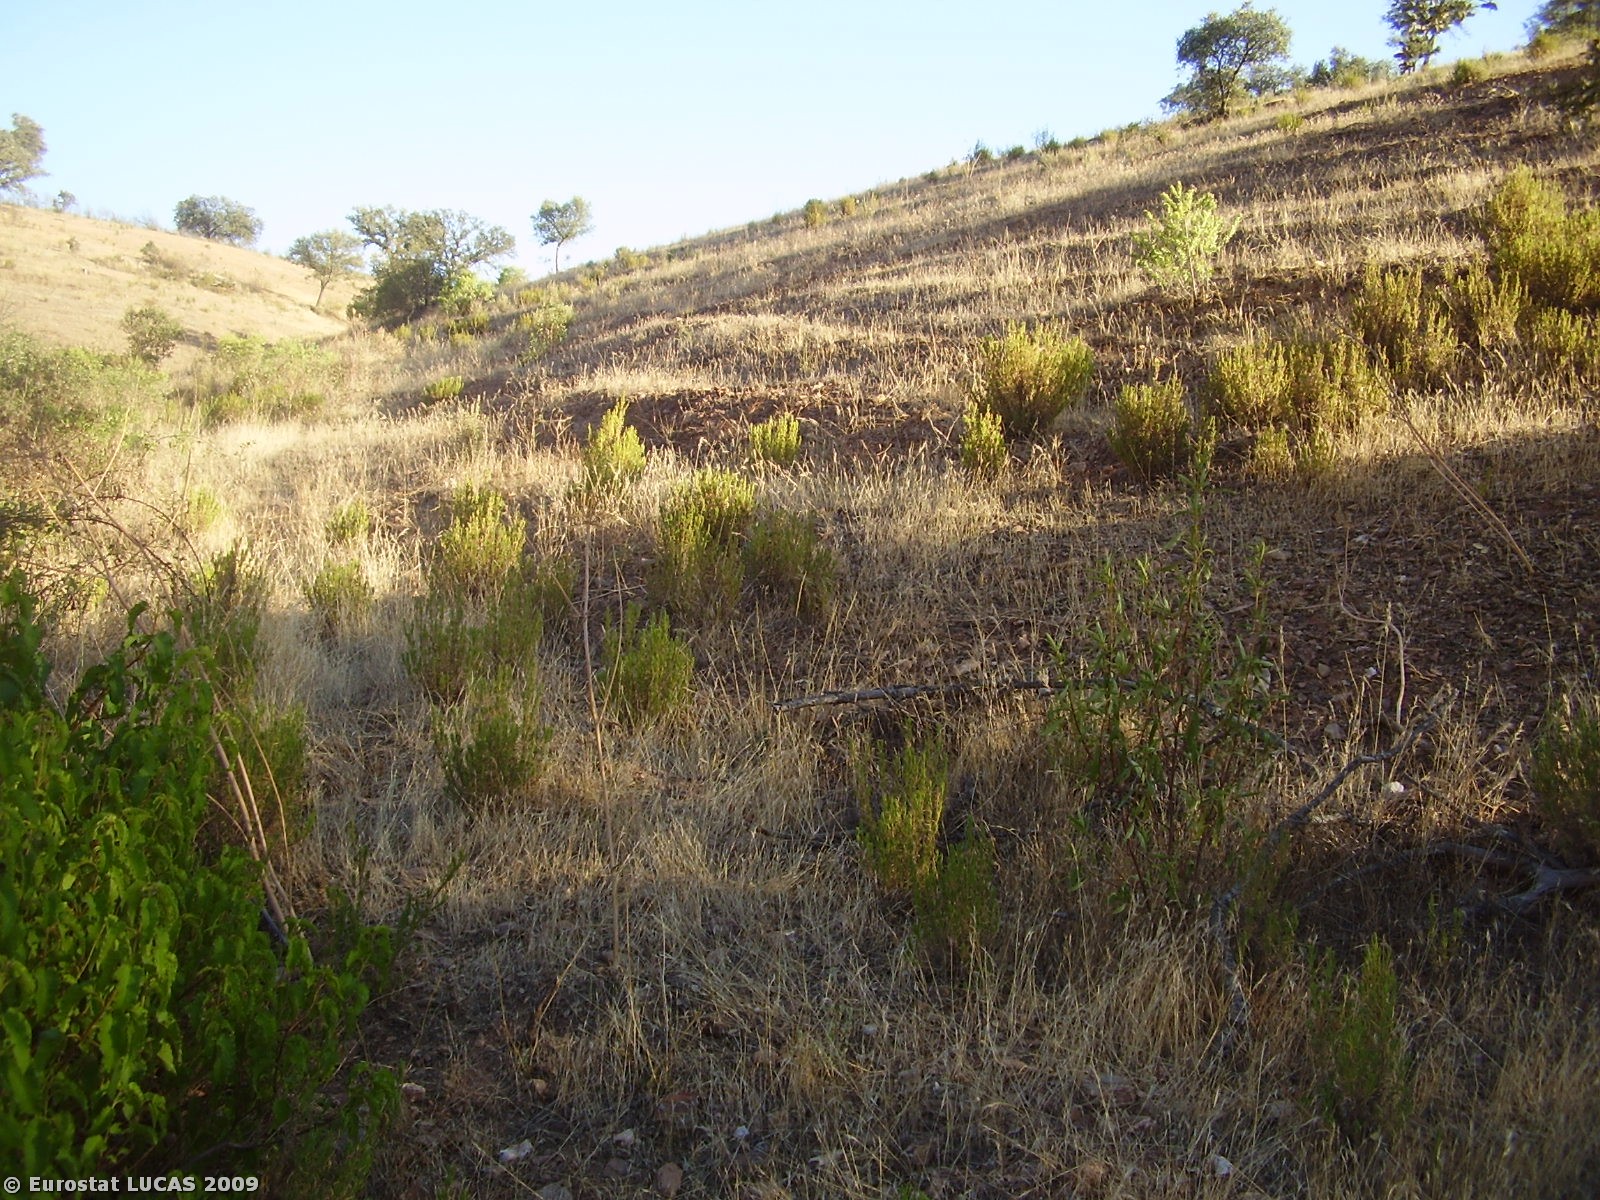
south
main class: Shrubland
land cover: Shrubland without tree cover
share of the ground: > 75 %
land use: Fallow land
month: July
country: PT
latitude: 37.8616
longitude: -7.5331
